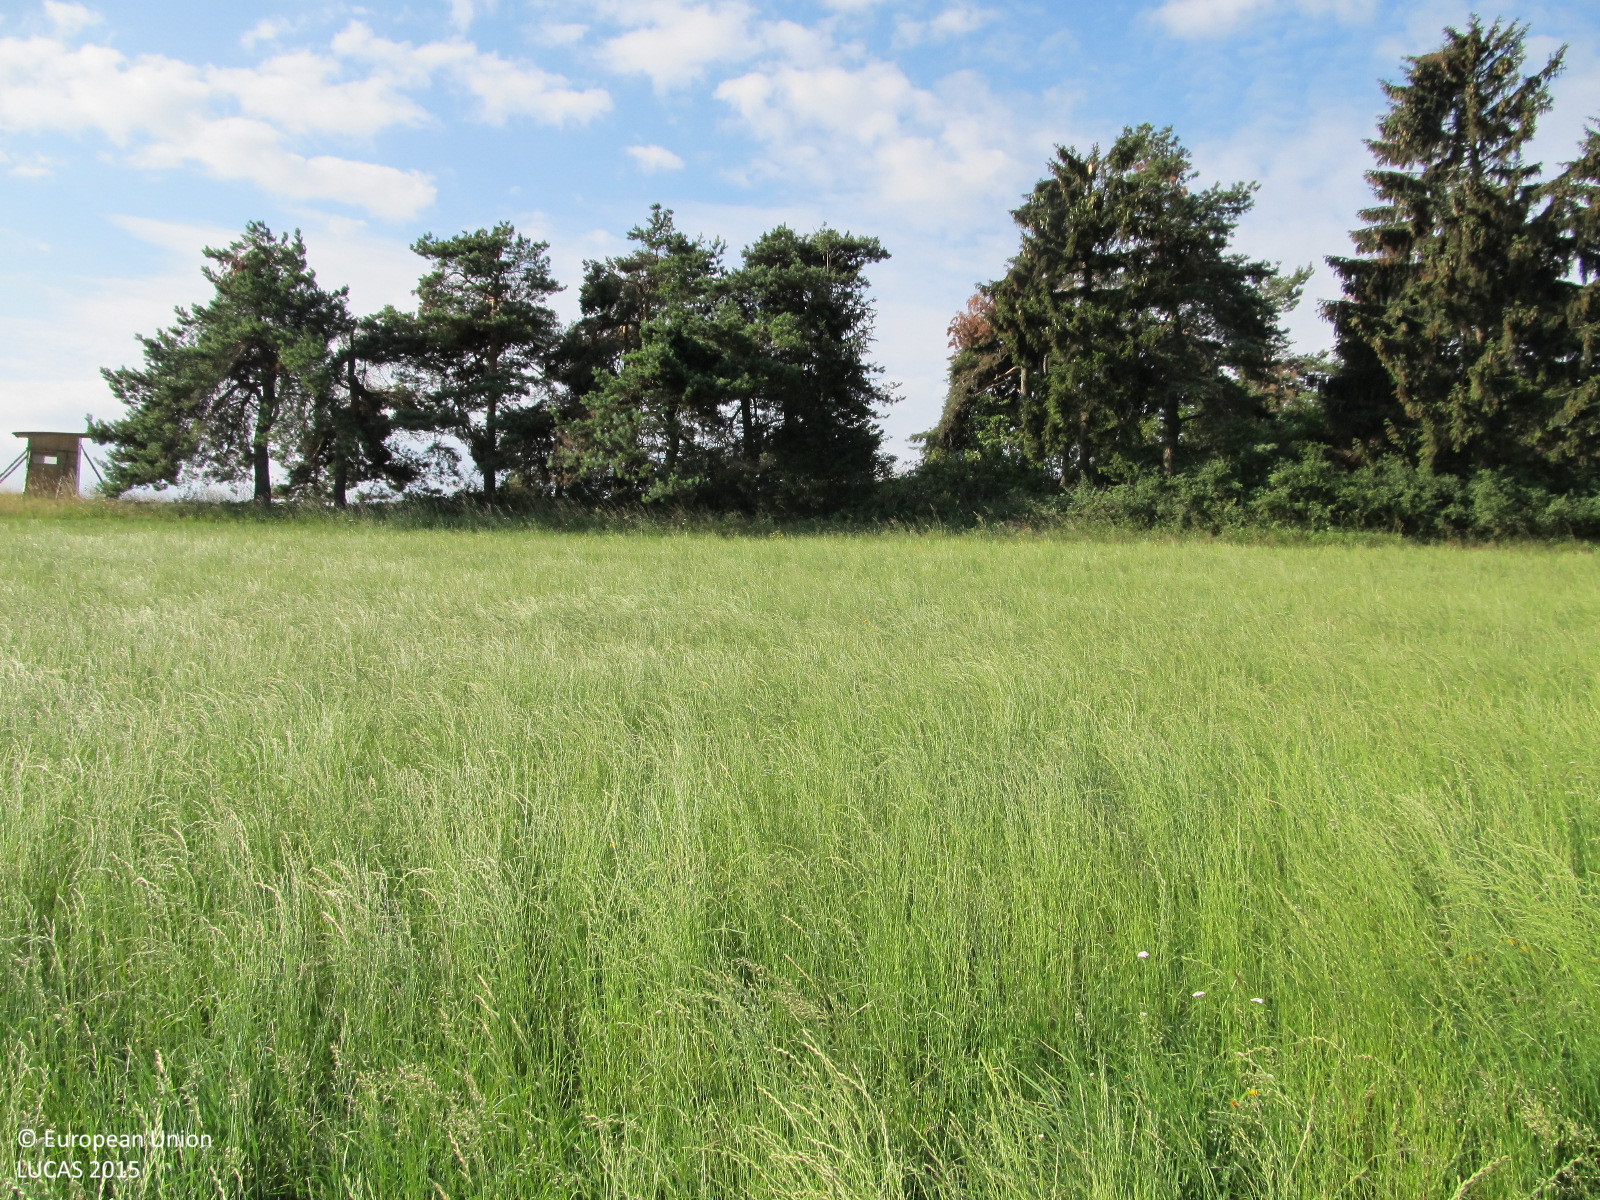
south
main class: Grassland
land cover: Grassland without tree/shrub cover
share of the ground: > 75 %
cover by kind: herbaceous plants 100 %
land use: Agriculture (excluding fallow land and kitchen gardens)
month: July
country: AT
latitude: 48.4162
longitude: 15.3934
